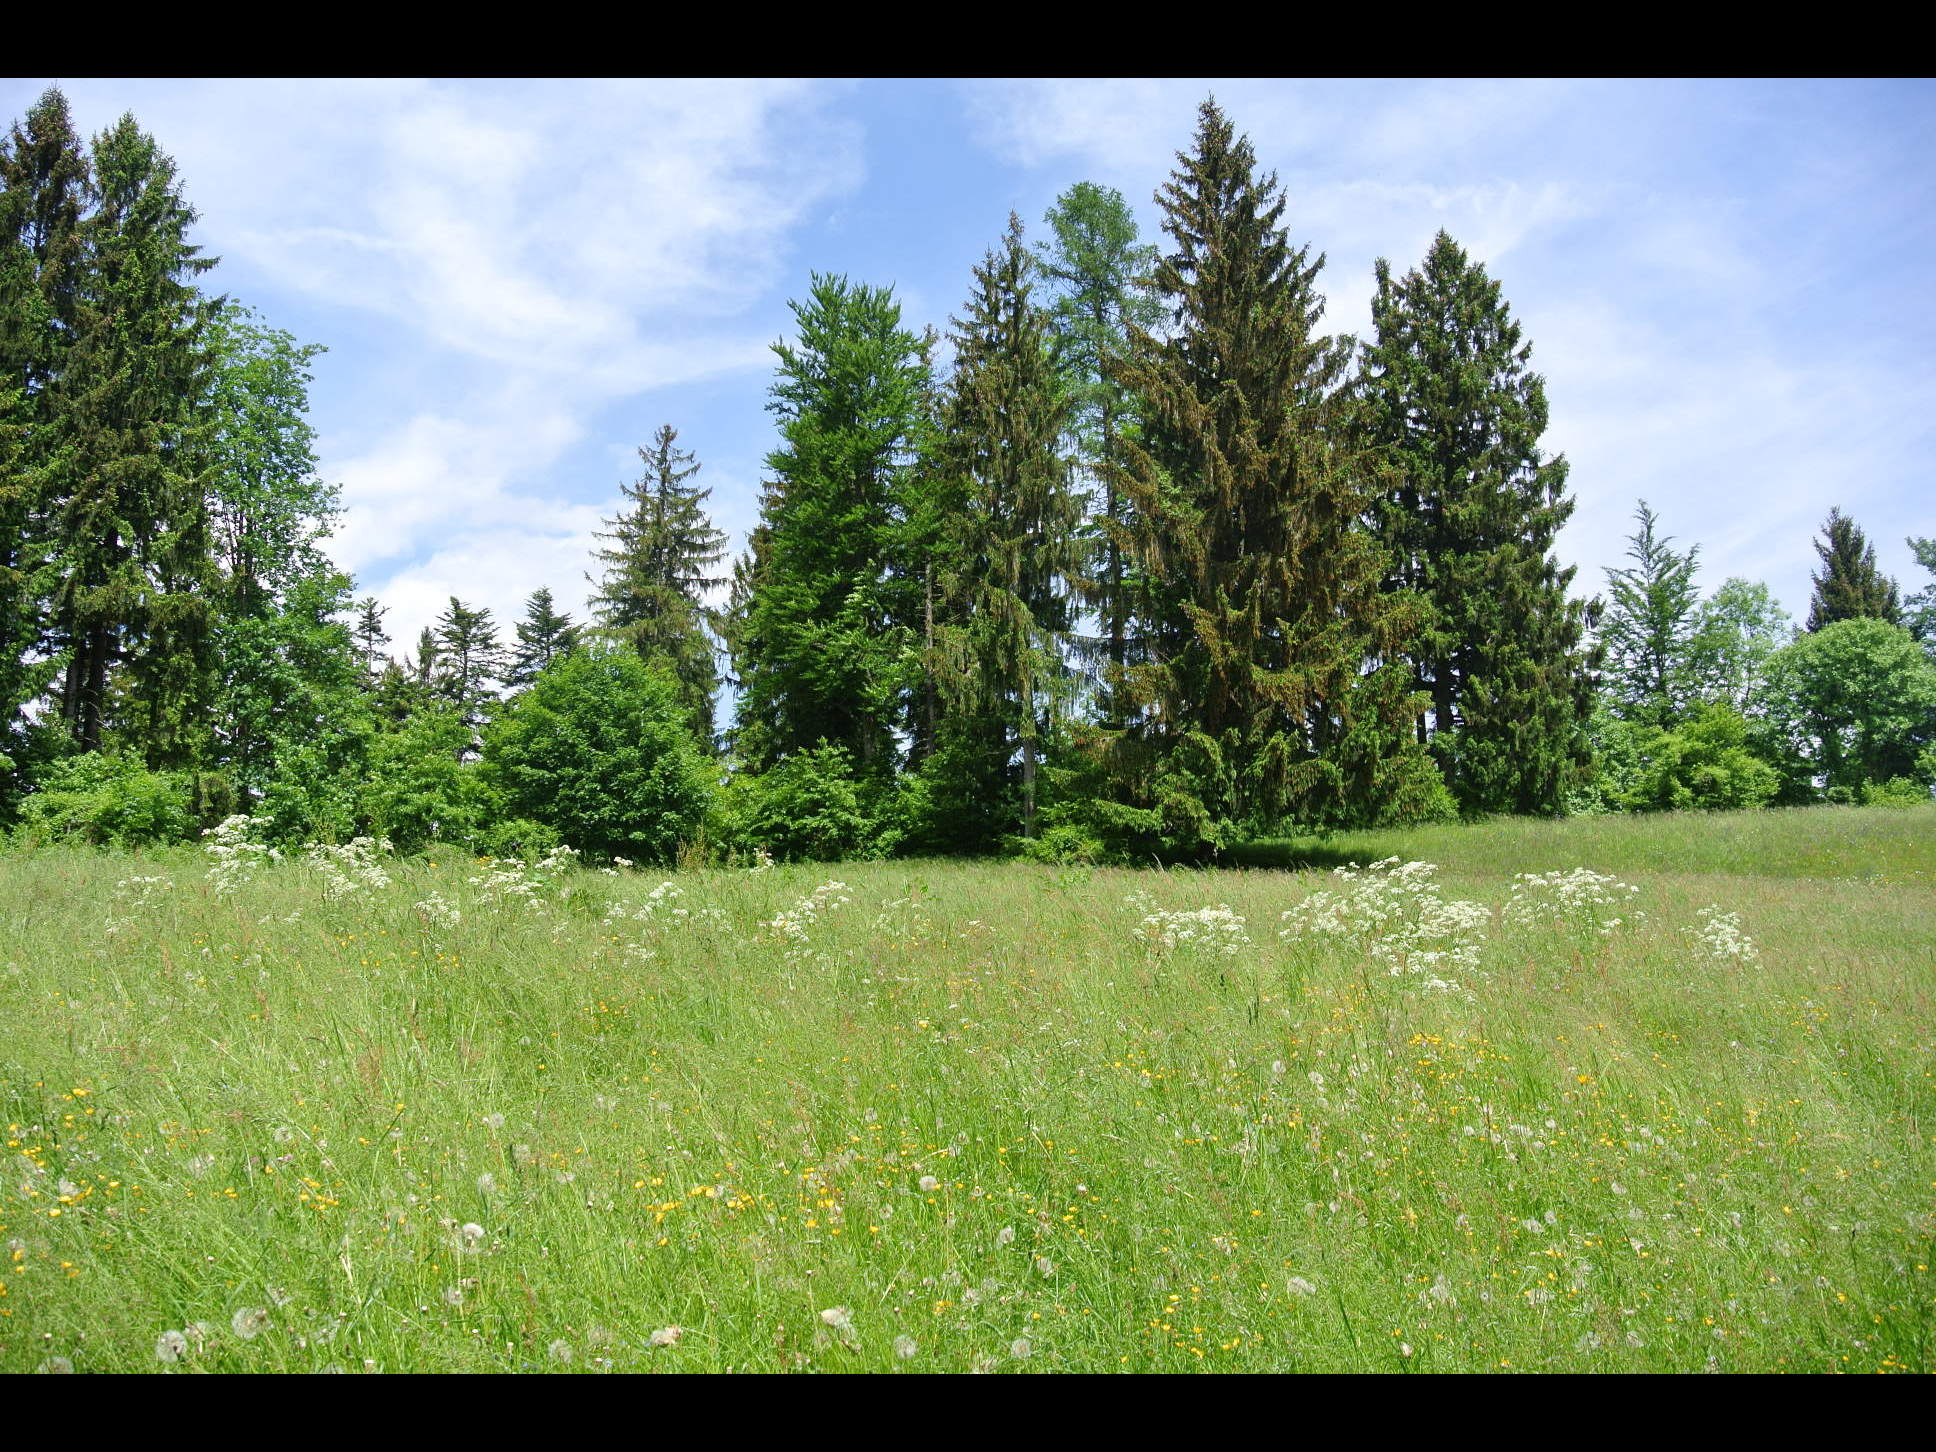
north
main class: Grassland
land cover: Grassland without tree/shrub cover
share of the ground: > 75 %
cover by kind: herbaceous plants 100 %
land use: Agriculture (excluding fallow land and kitchen gardens)
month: May
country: AT
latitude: 48.0163
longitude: 15.8079
